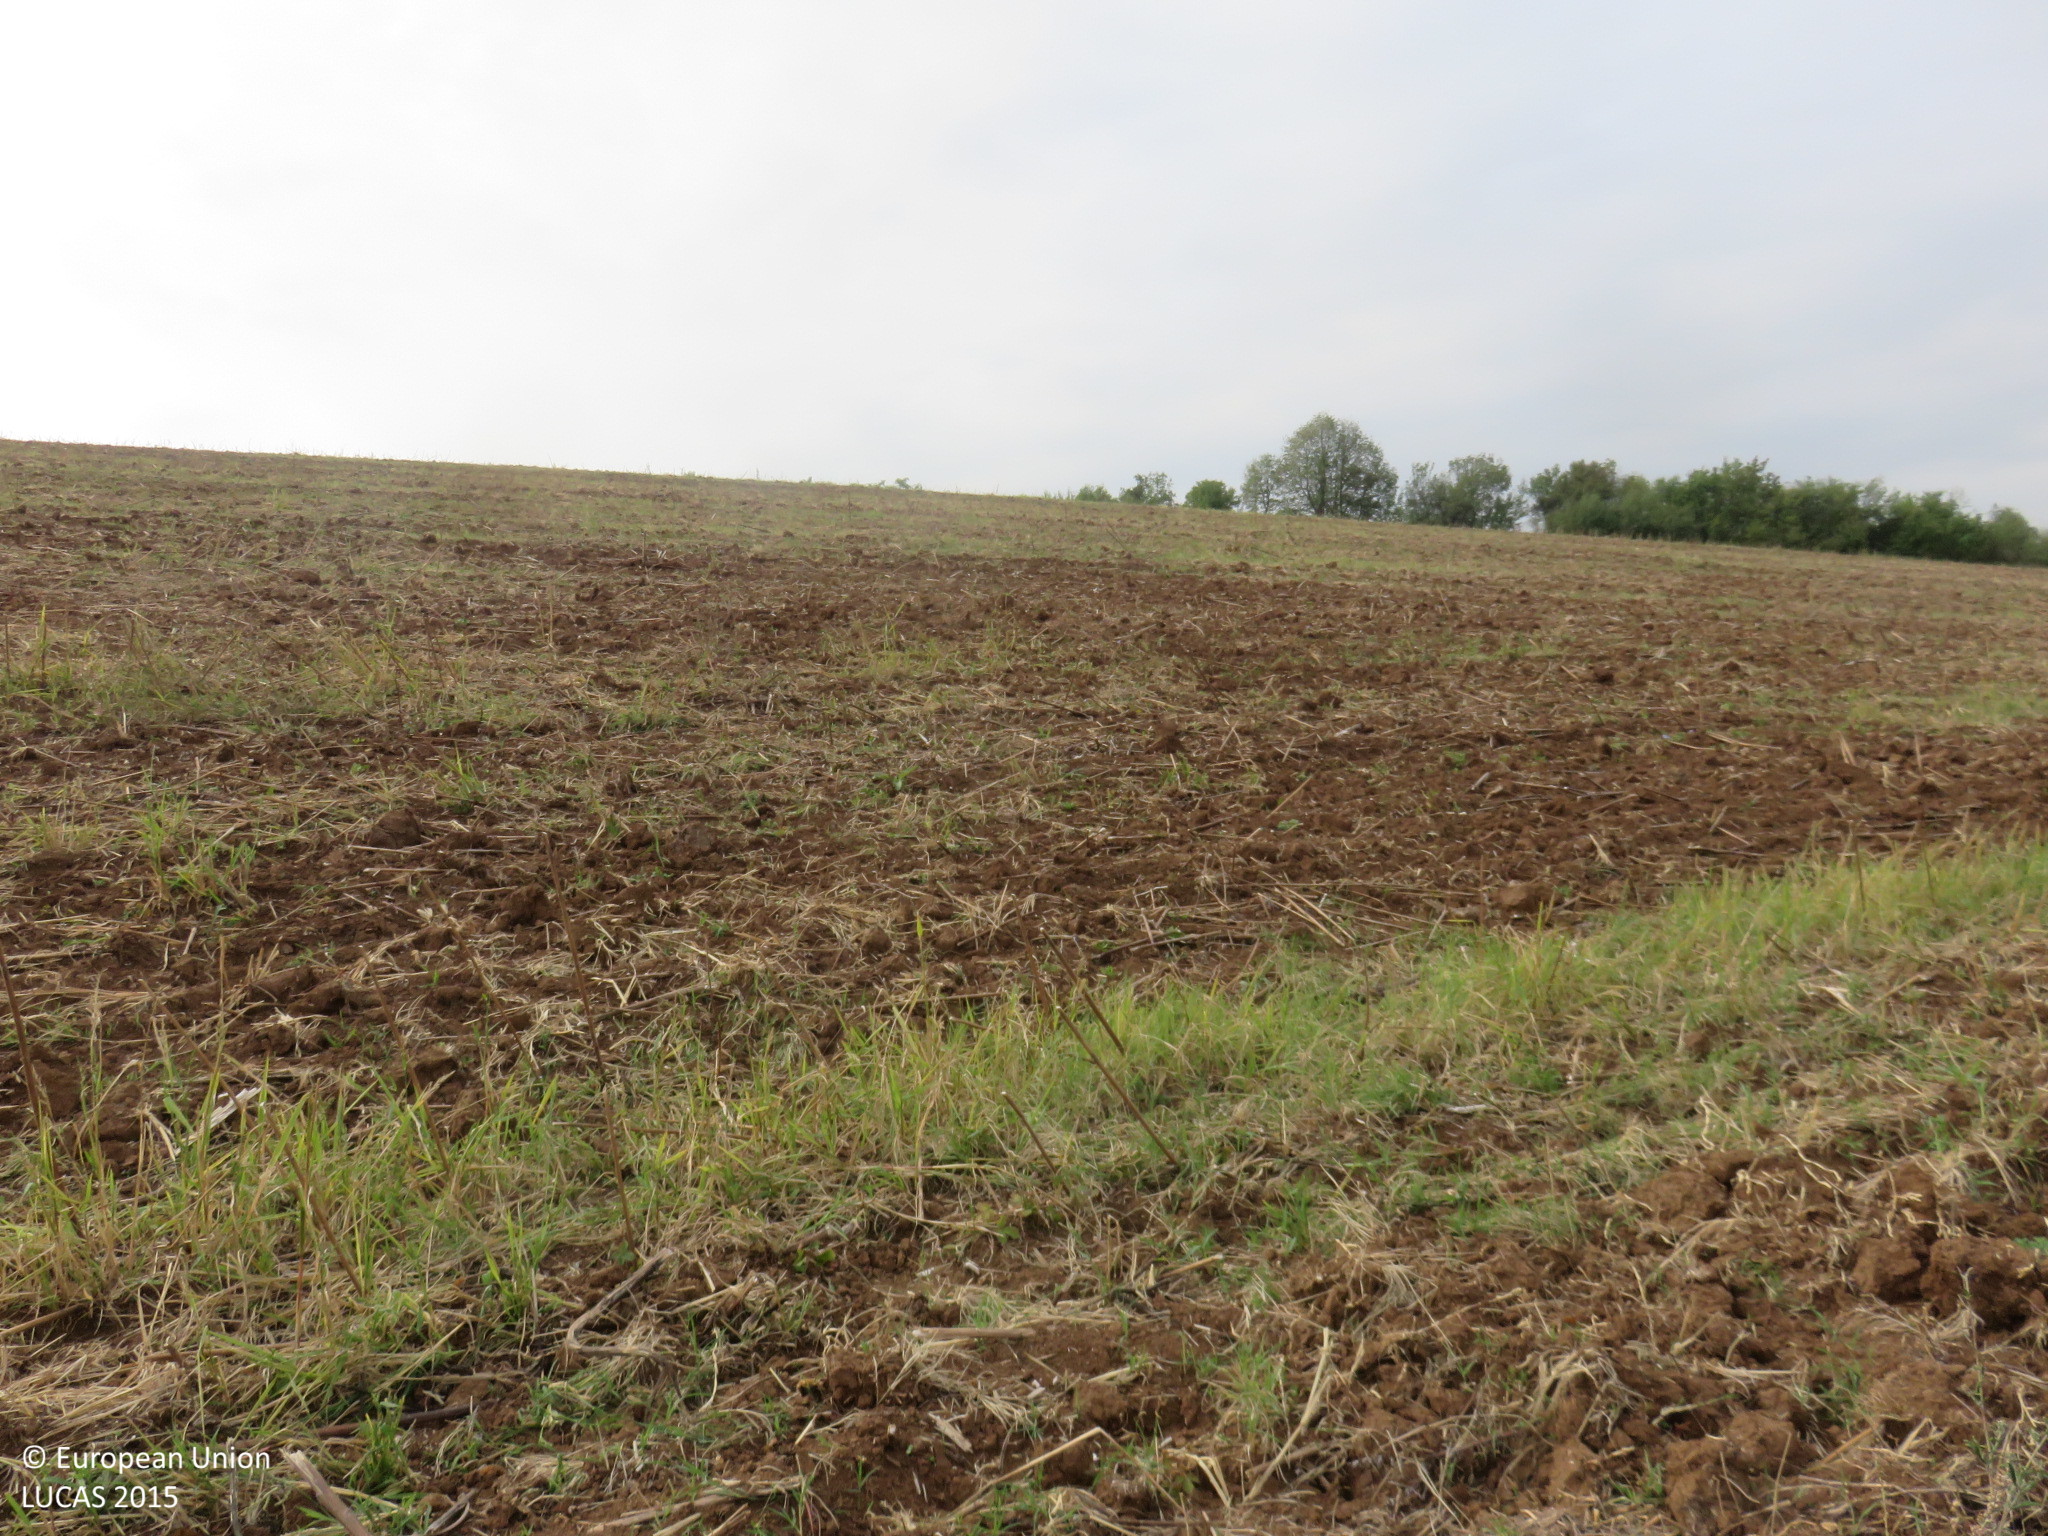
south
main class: Shrubland
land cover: Shrubland with sparse tree cover
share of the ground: > 75 %
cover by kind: shrubs 90 %, broadleaved forest trees 5 %, herbaceous plants 5 %
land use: Semi-natural and natural areas not in use
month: September
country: BG
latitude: 43.1988
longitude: 24.8702
